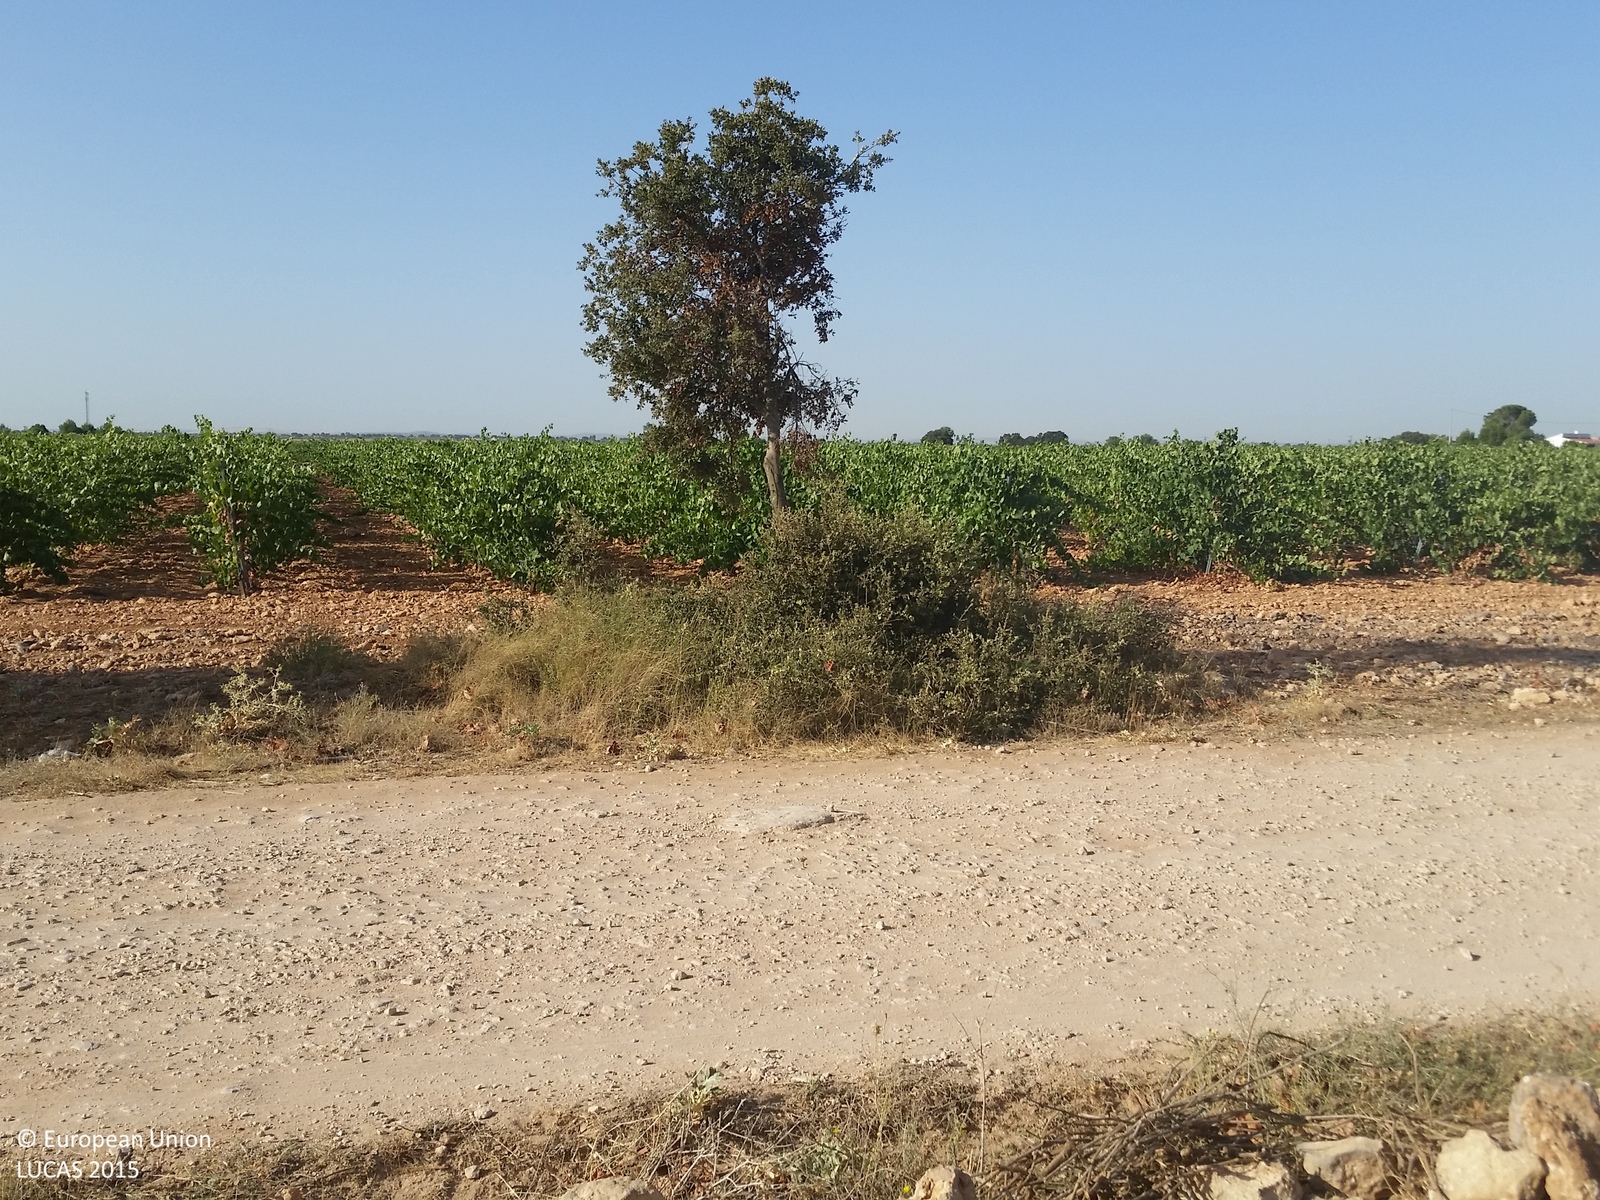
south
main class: Cropland
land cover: Vineyards
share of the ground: 50 - 75 %
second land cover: Other bare soil
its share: > 75 %
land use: Agriculture (excluding fallow land and kitchen gardens)
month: July
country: ES
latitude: 39.2971
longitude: -2.6615
